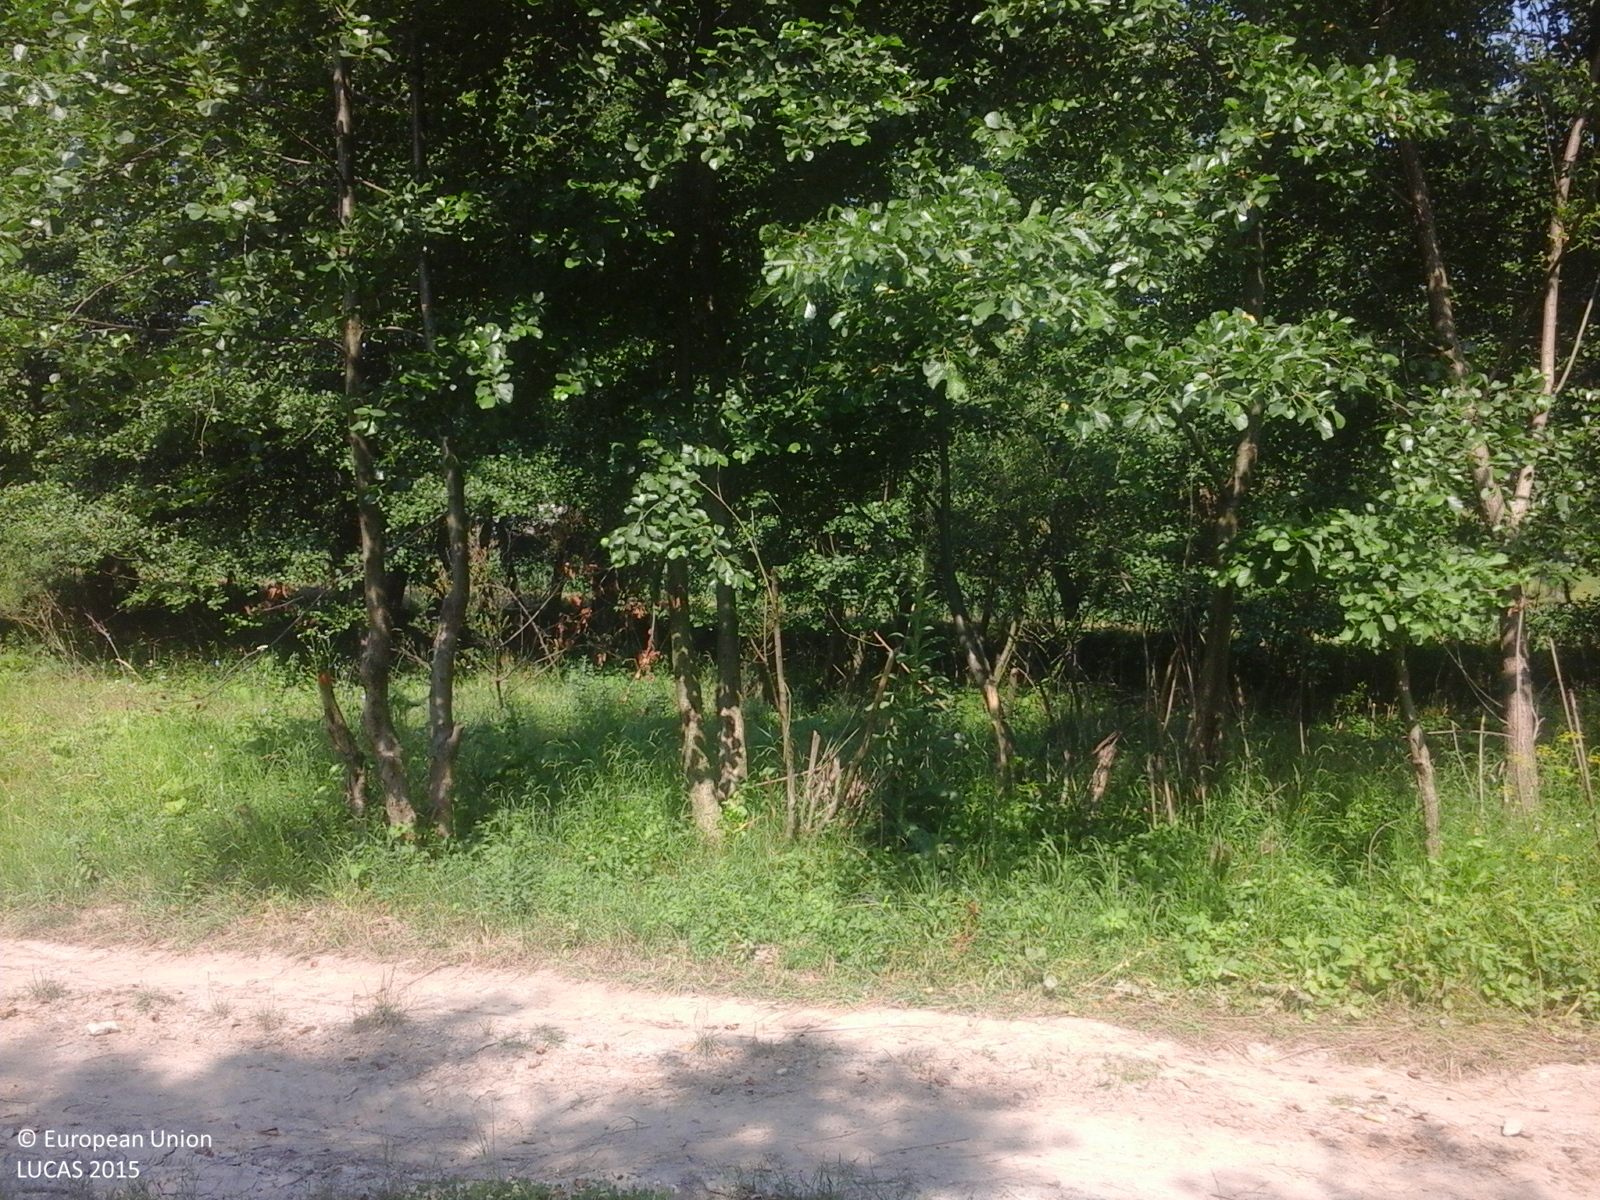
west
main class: Woodland
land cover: Broadleaved woodland
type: beech forest
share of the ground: > 75 %
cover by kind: broadleaved forest trees 100 %
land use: Forestry
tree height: > 5 m
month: July
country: RO
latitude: 45.1245
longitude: 25.1034
